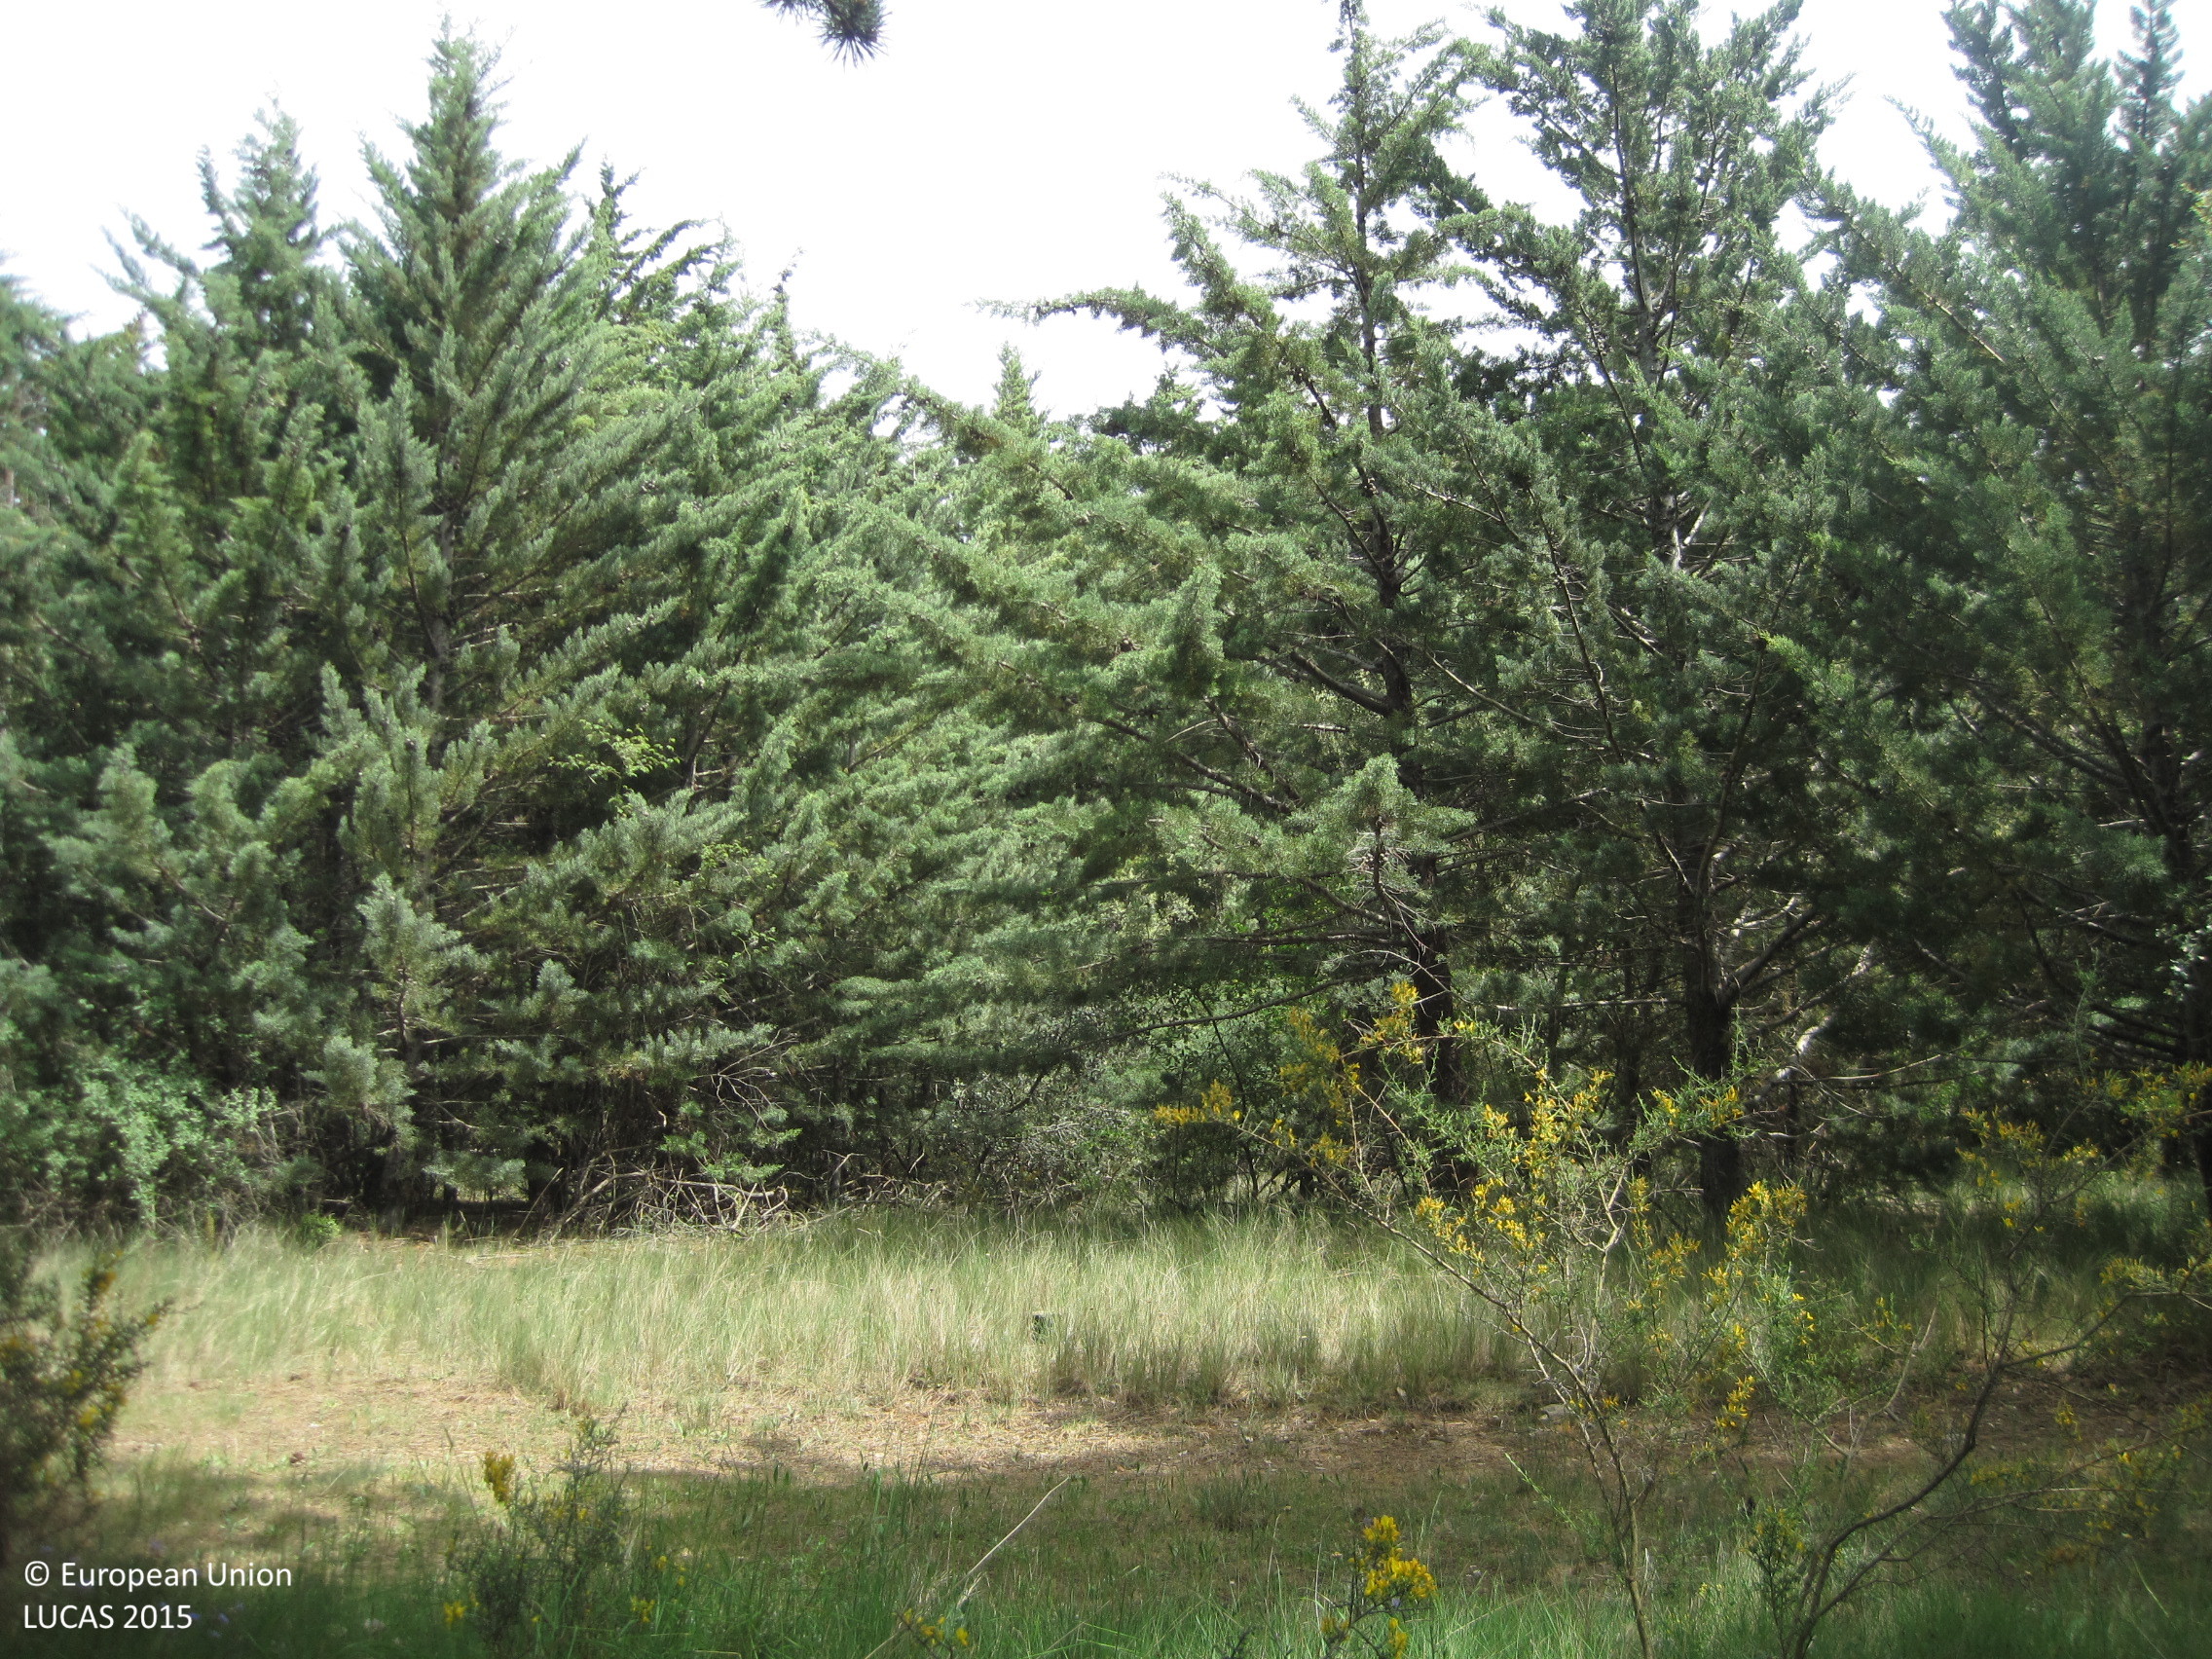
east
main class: Woodland
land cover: Pine dominated coniferous woodland
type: coniferous forest of the mediterranean region
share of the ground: > 75 %
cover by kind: coniferous forest trees 100 %
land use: Forestry
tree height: > 5 m
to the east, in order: Pine dominated coniferous woodland; Tracks; Pine dominated coniferous woodland; Fences; Grassland without tree/shrub cover; Paved roads, cycling and walking lanes; Grassland without tree/shrub cover; Managed hedges; Grassland without tree/shrub cover; Paved roads, cycling and walking lanes; Grassland without tree/shrub cover; Fences; Tracks; Grassland without tree/shrub cover; Pine dominated mixed woodland; Rape and turnip rape
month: May
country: ES
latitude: 42.6372
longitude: -1.6351
